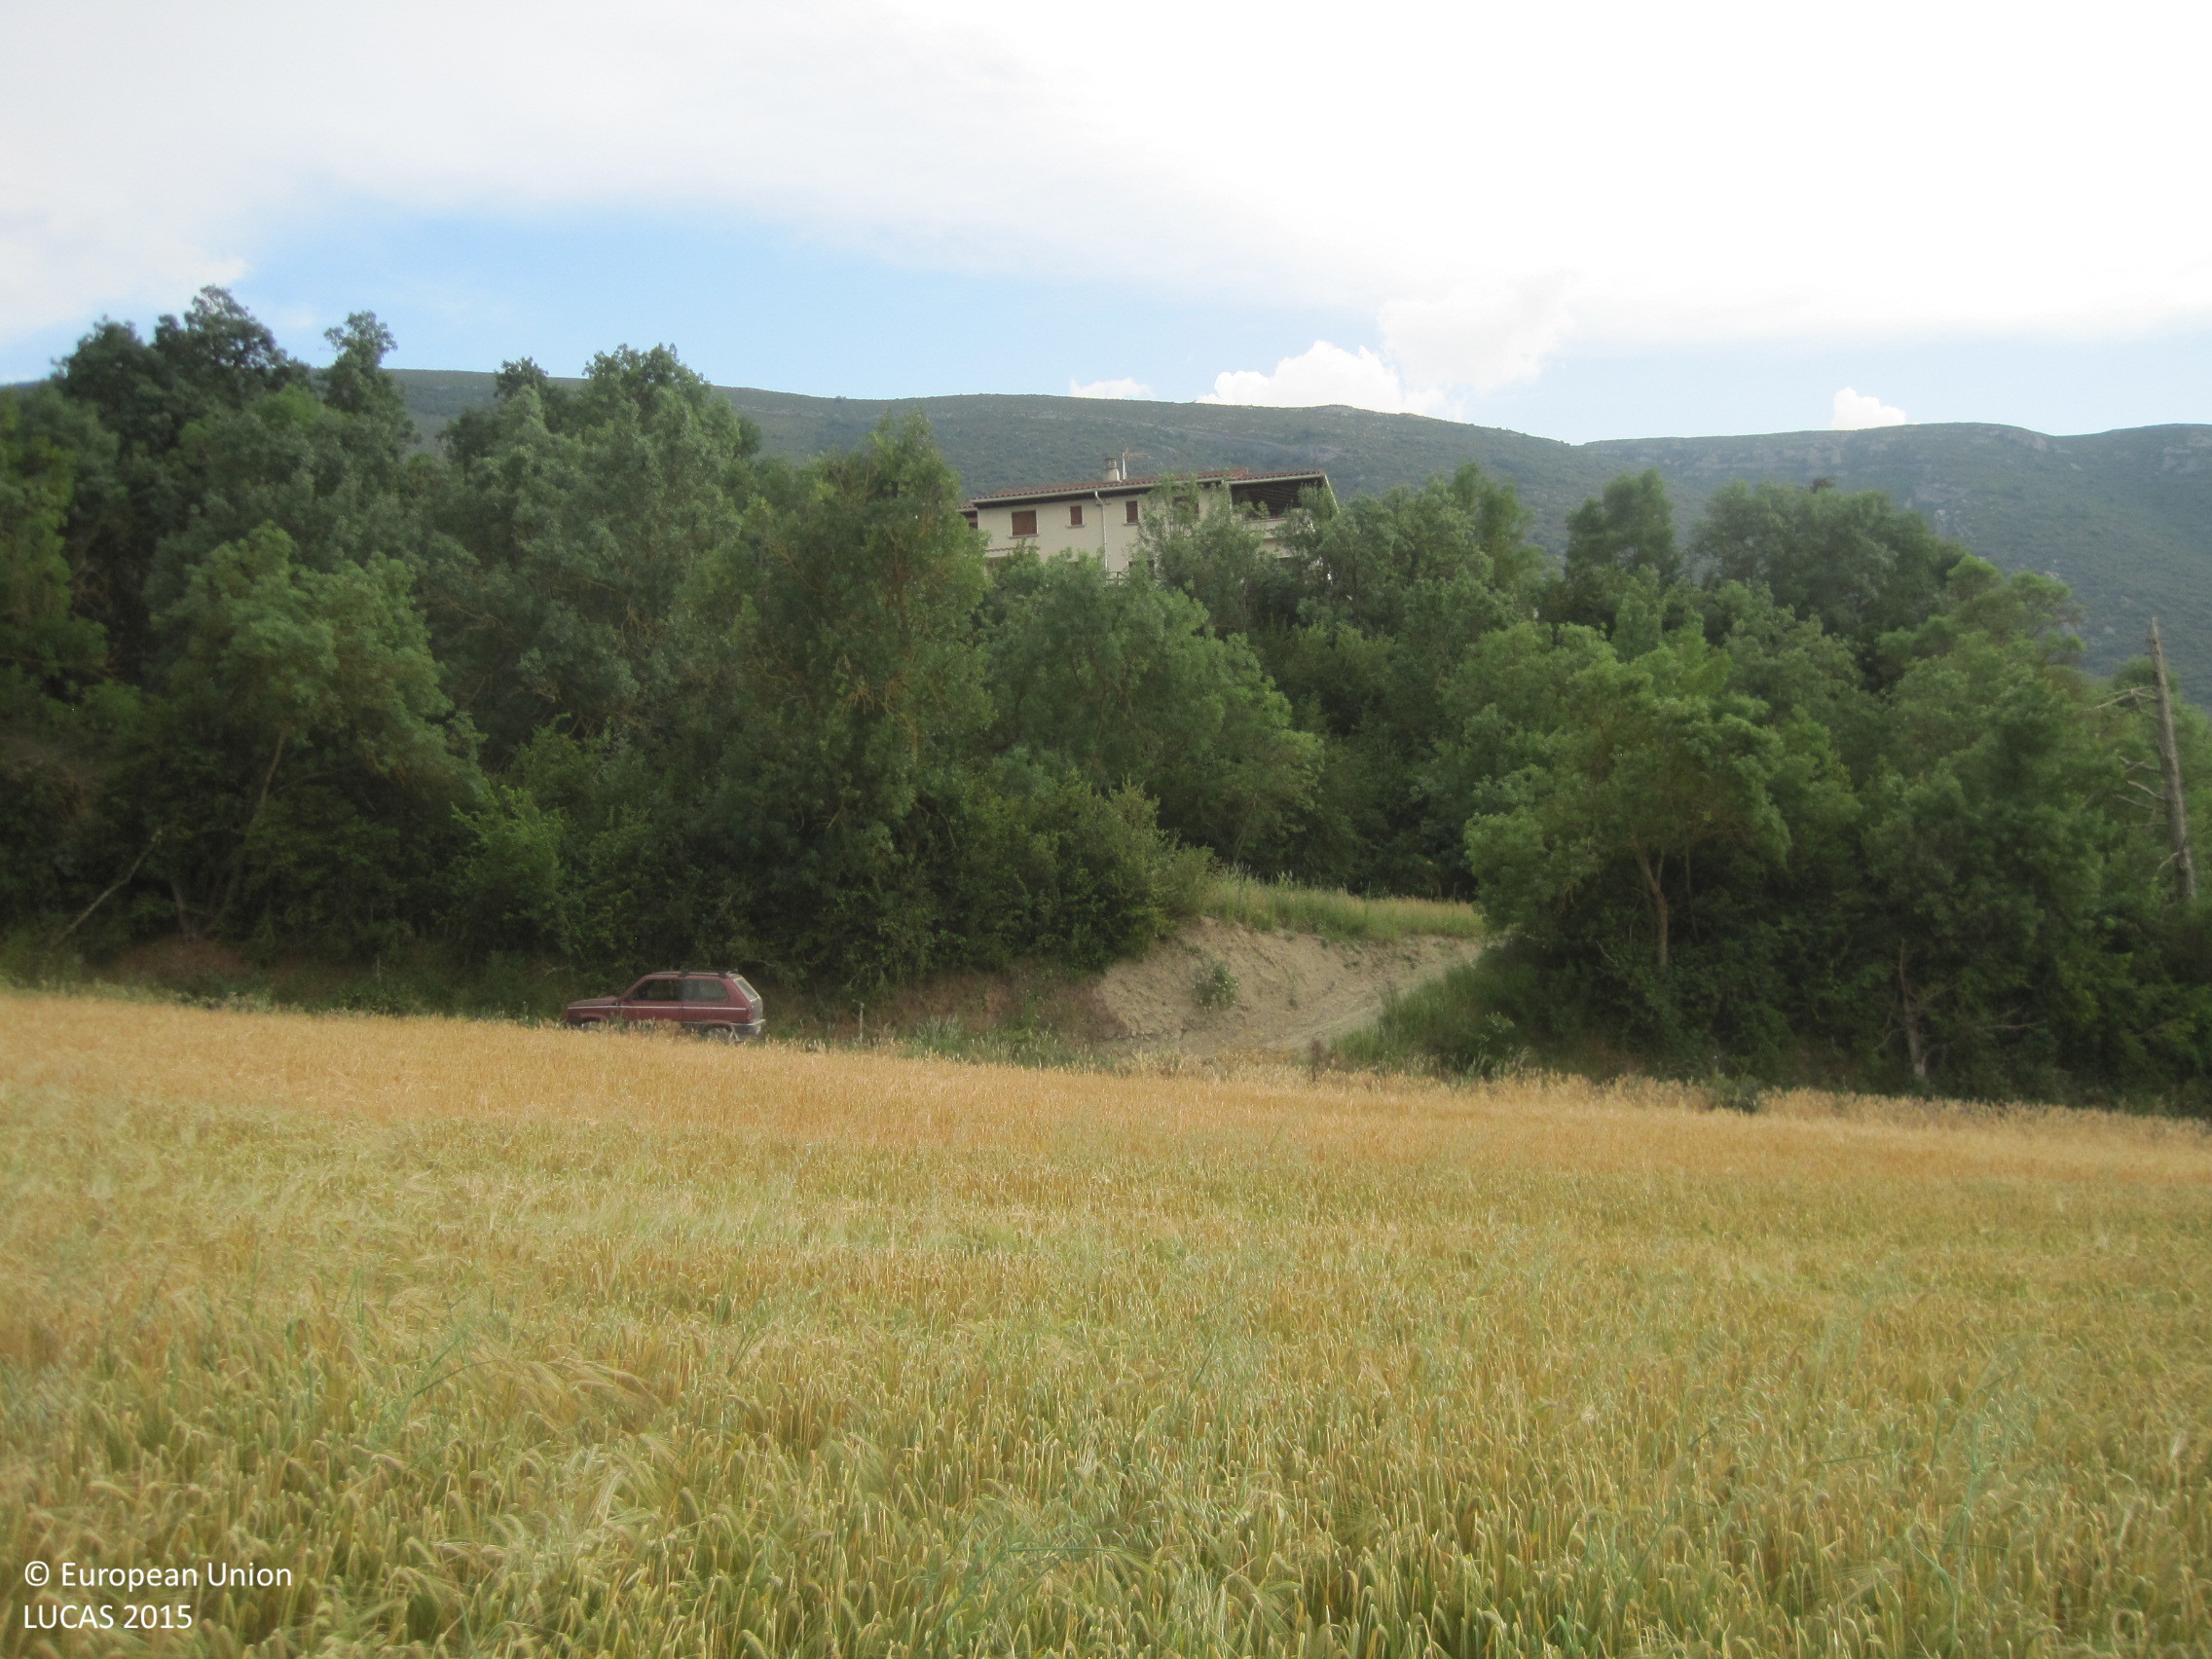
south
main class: Cropland
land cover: Barley
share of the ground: > 75 %
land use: Agriculture (excluding fallow land and kitchen gardens)
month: June
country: ES
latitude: 42.6659
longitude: -1.2218
